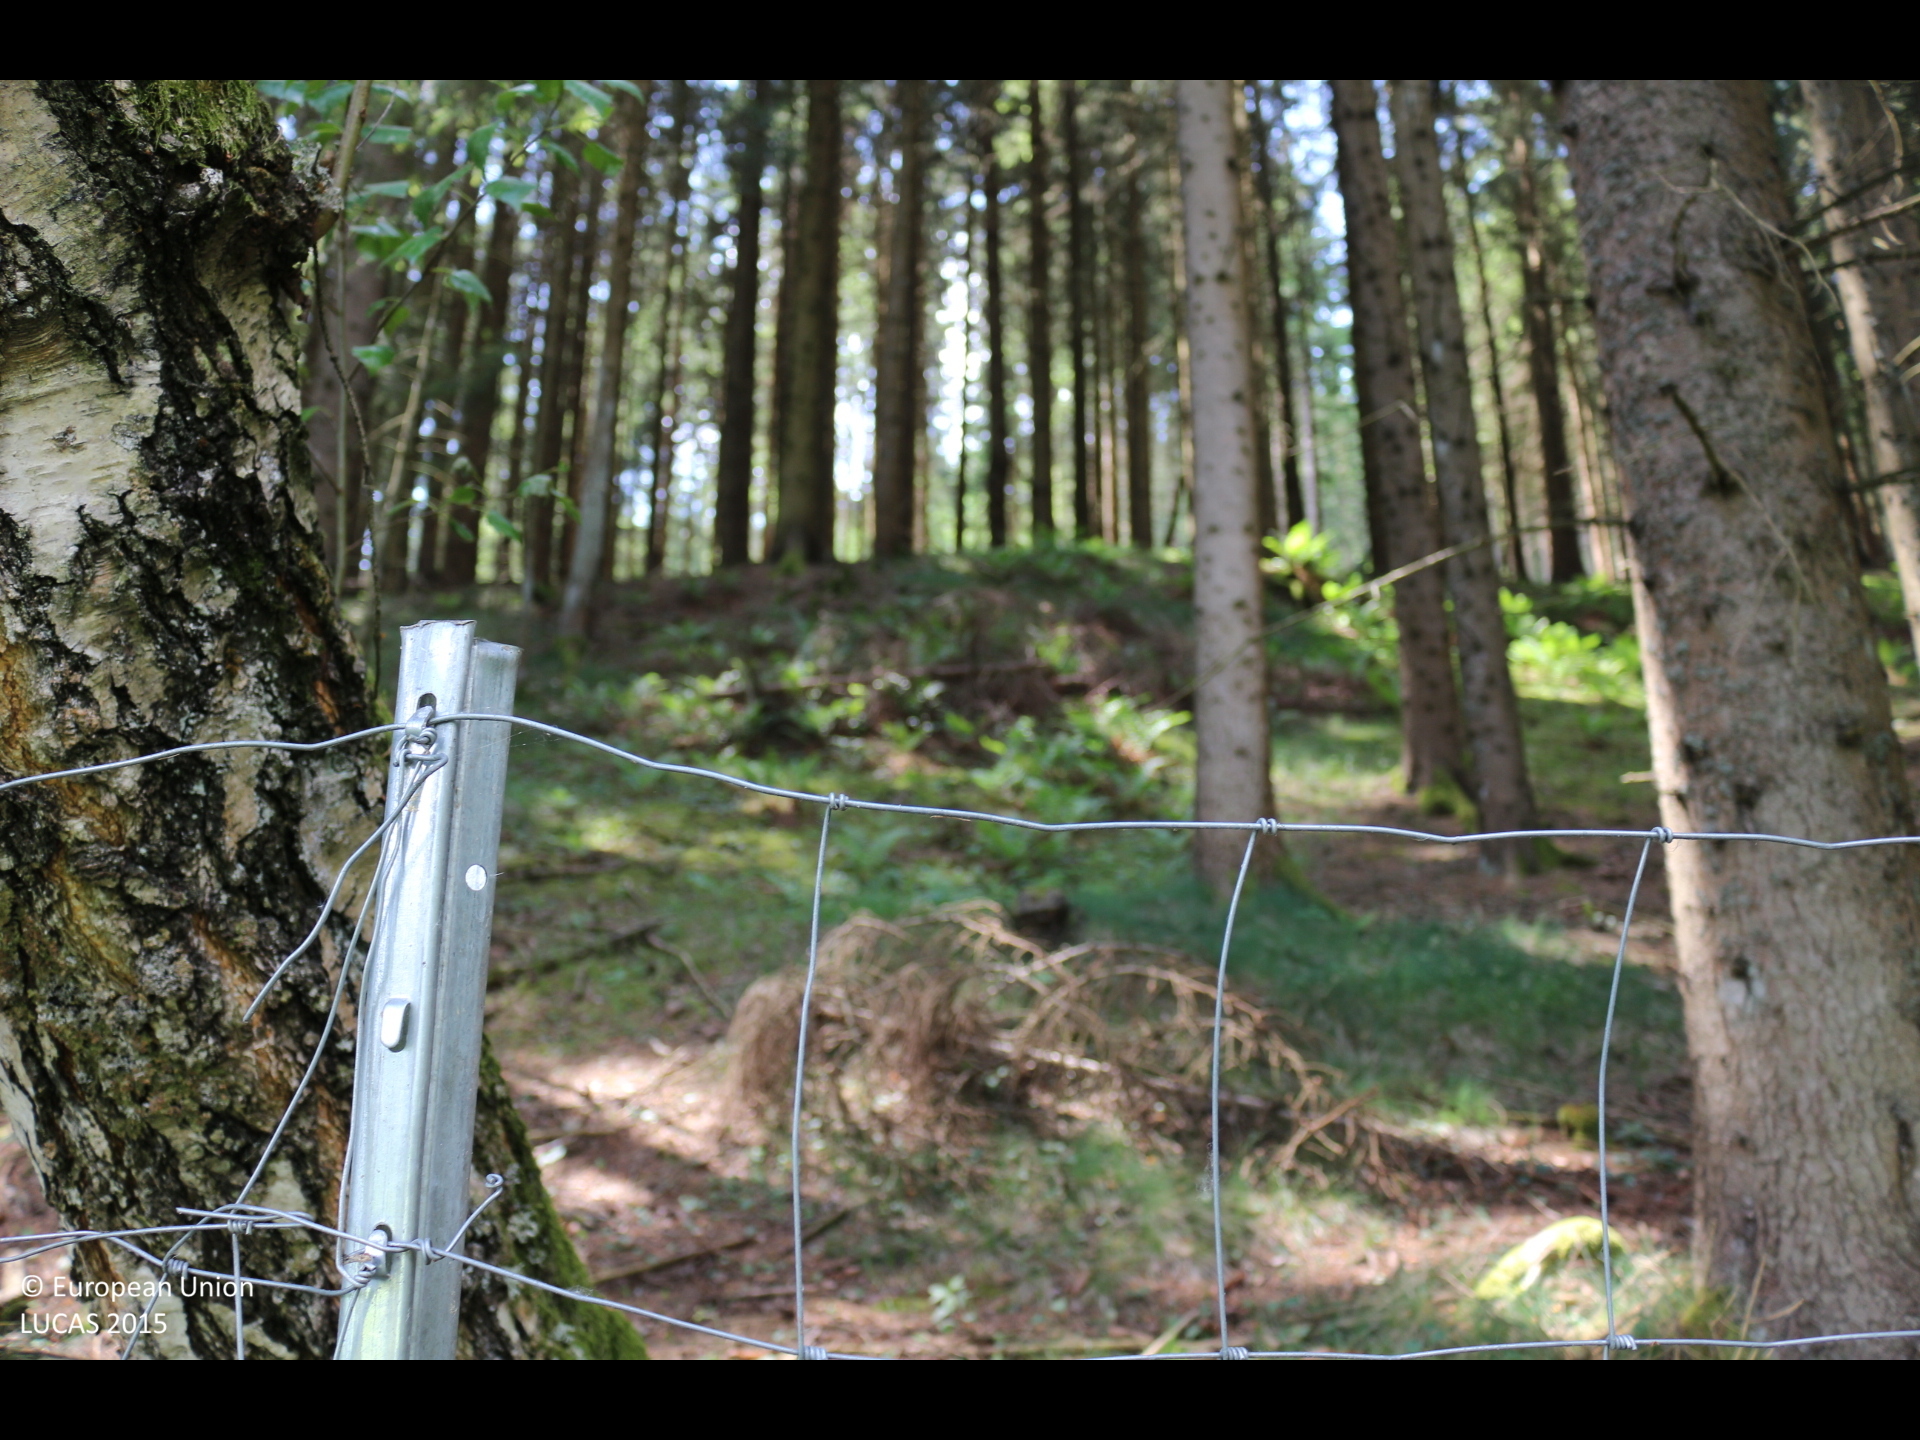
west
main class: Woodland
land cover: Spruce dominated coniferous woodland
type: alpine coniferous forest
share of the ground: > 75 %
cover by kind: coniferous forest trees 100 %
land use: Forestry
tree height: > 5 m
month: May
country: AT
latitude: 46.7706
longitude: 14.2798
